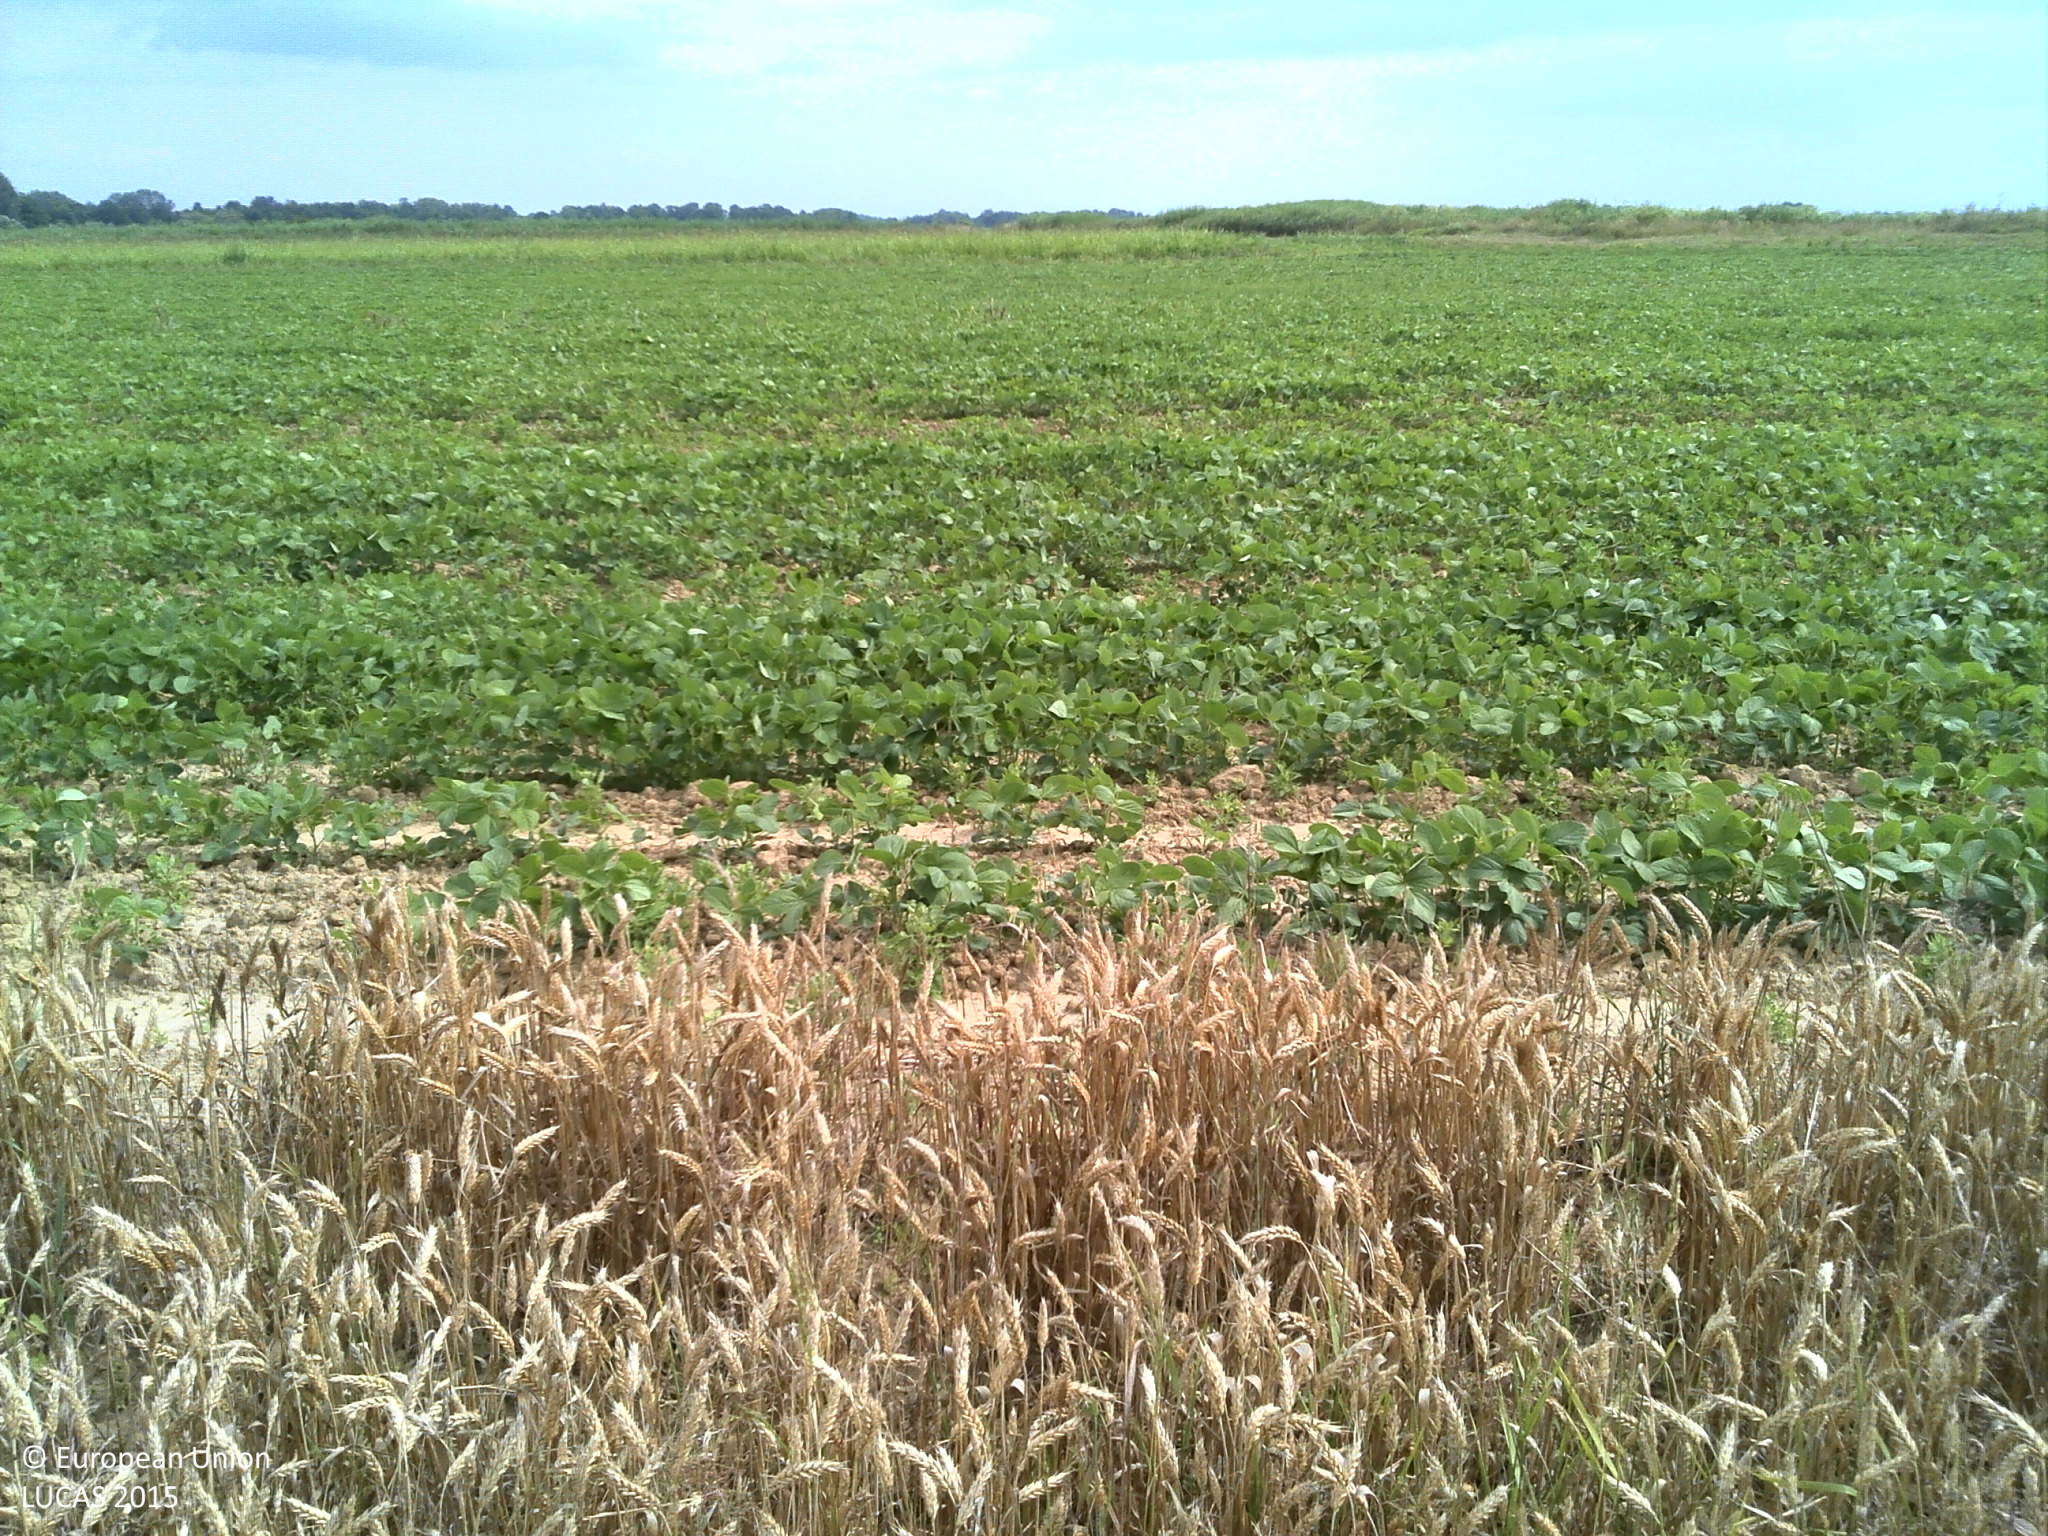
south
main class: Cropland
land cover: Common wheat
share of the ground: > 75 %
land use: Agriculture (excluding fallow land and kitchen gardens)
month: June
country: HR
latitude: 45.2246
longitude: 17.4251
